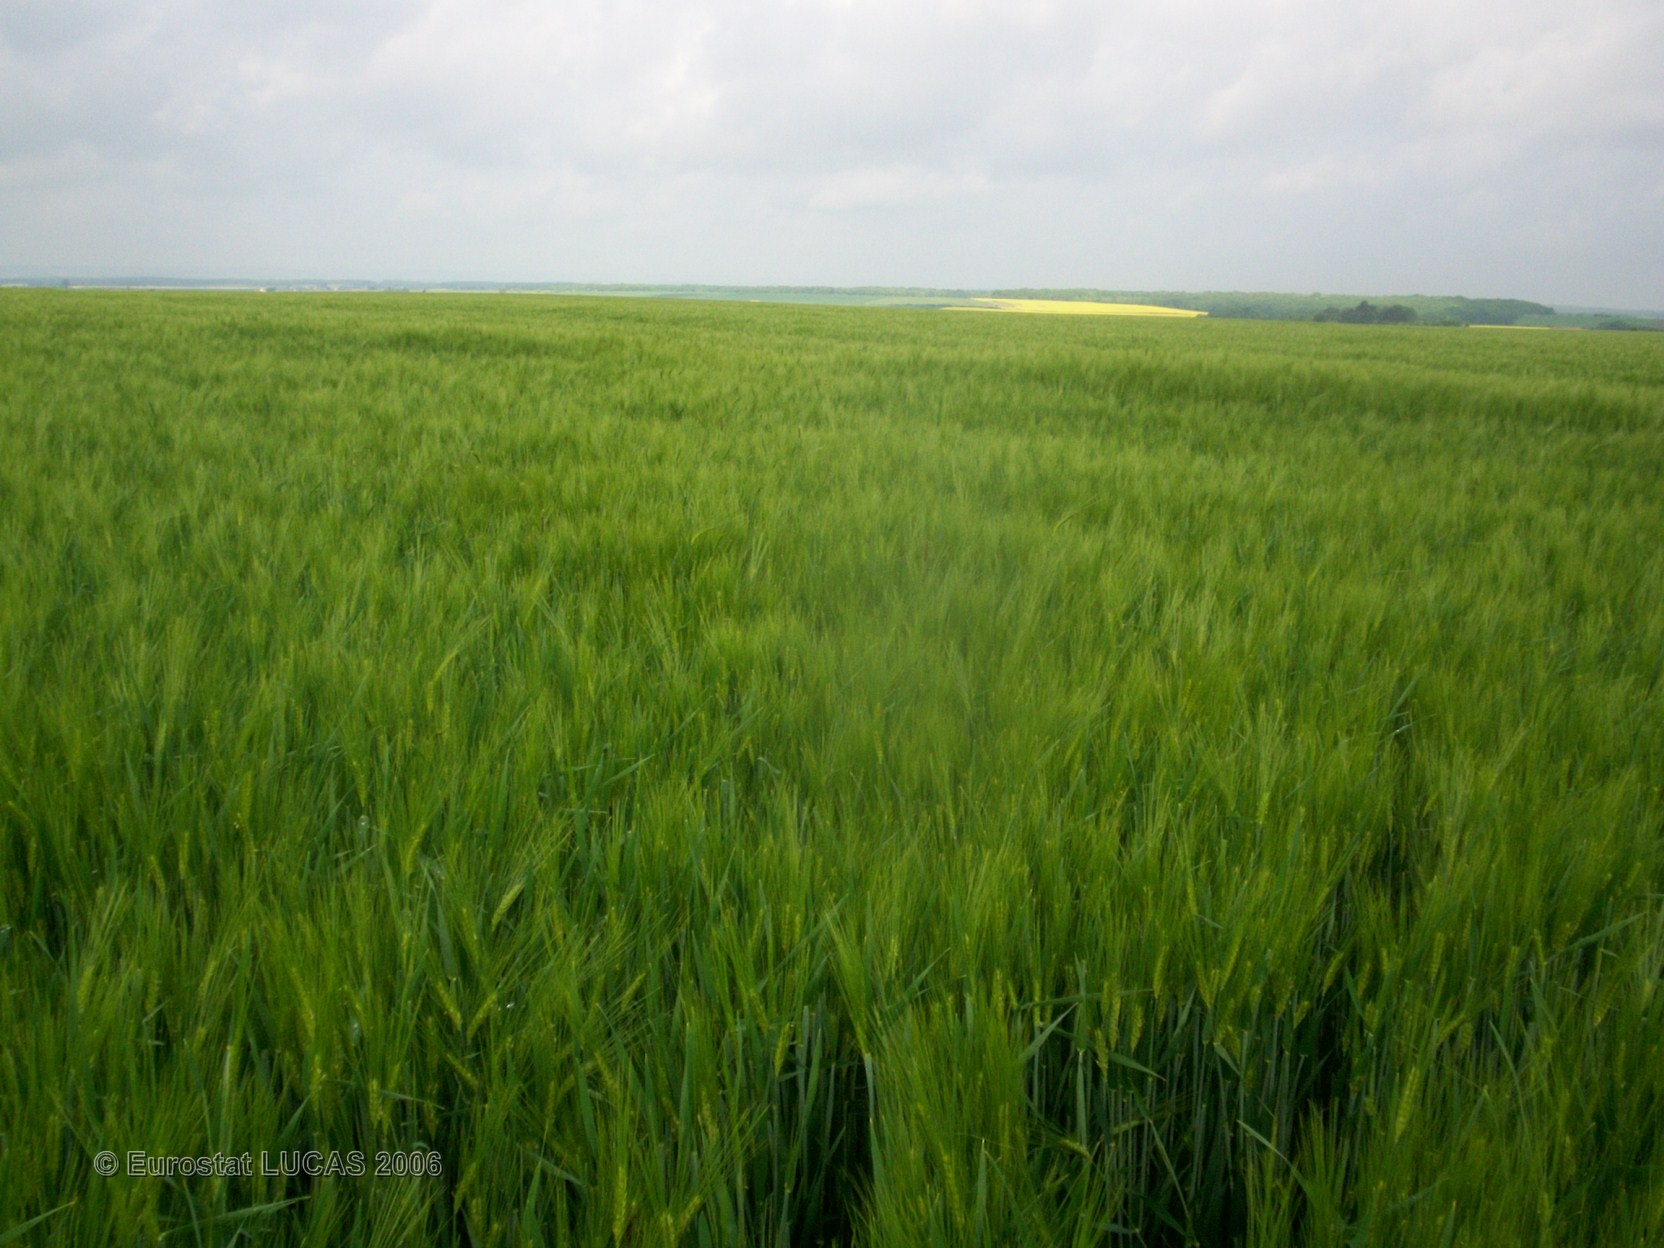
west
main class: Cropland
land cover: Barley
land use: Agriculture (excluding fallow land and kitchen gardens)
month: May
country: FR
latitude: 49.1012
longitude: 5.8766
